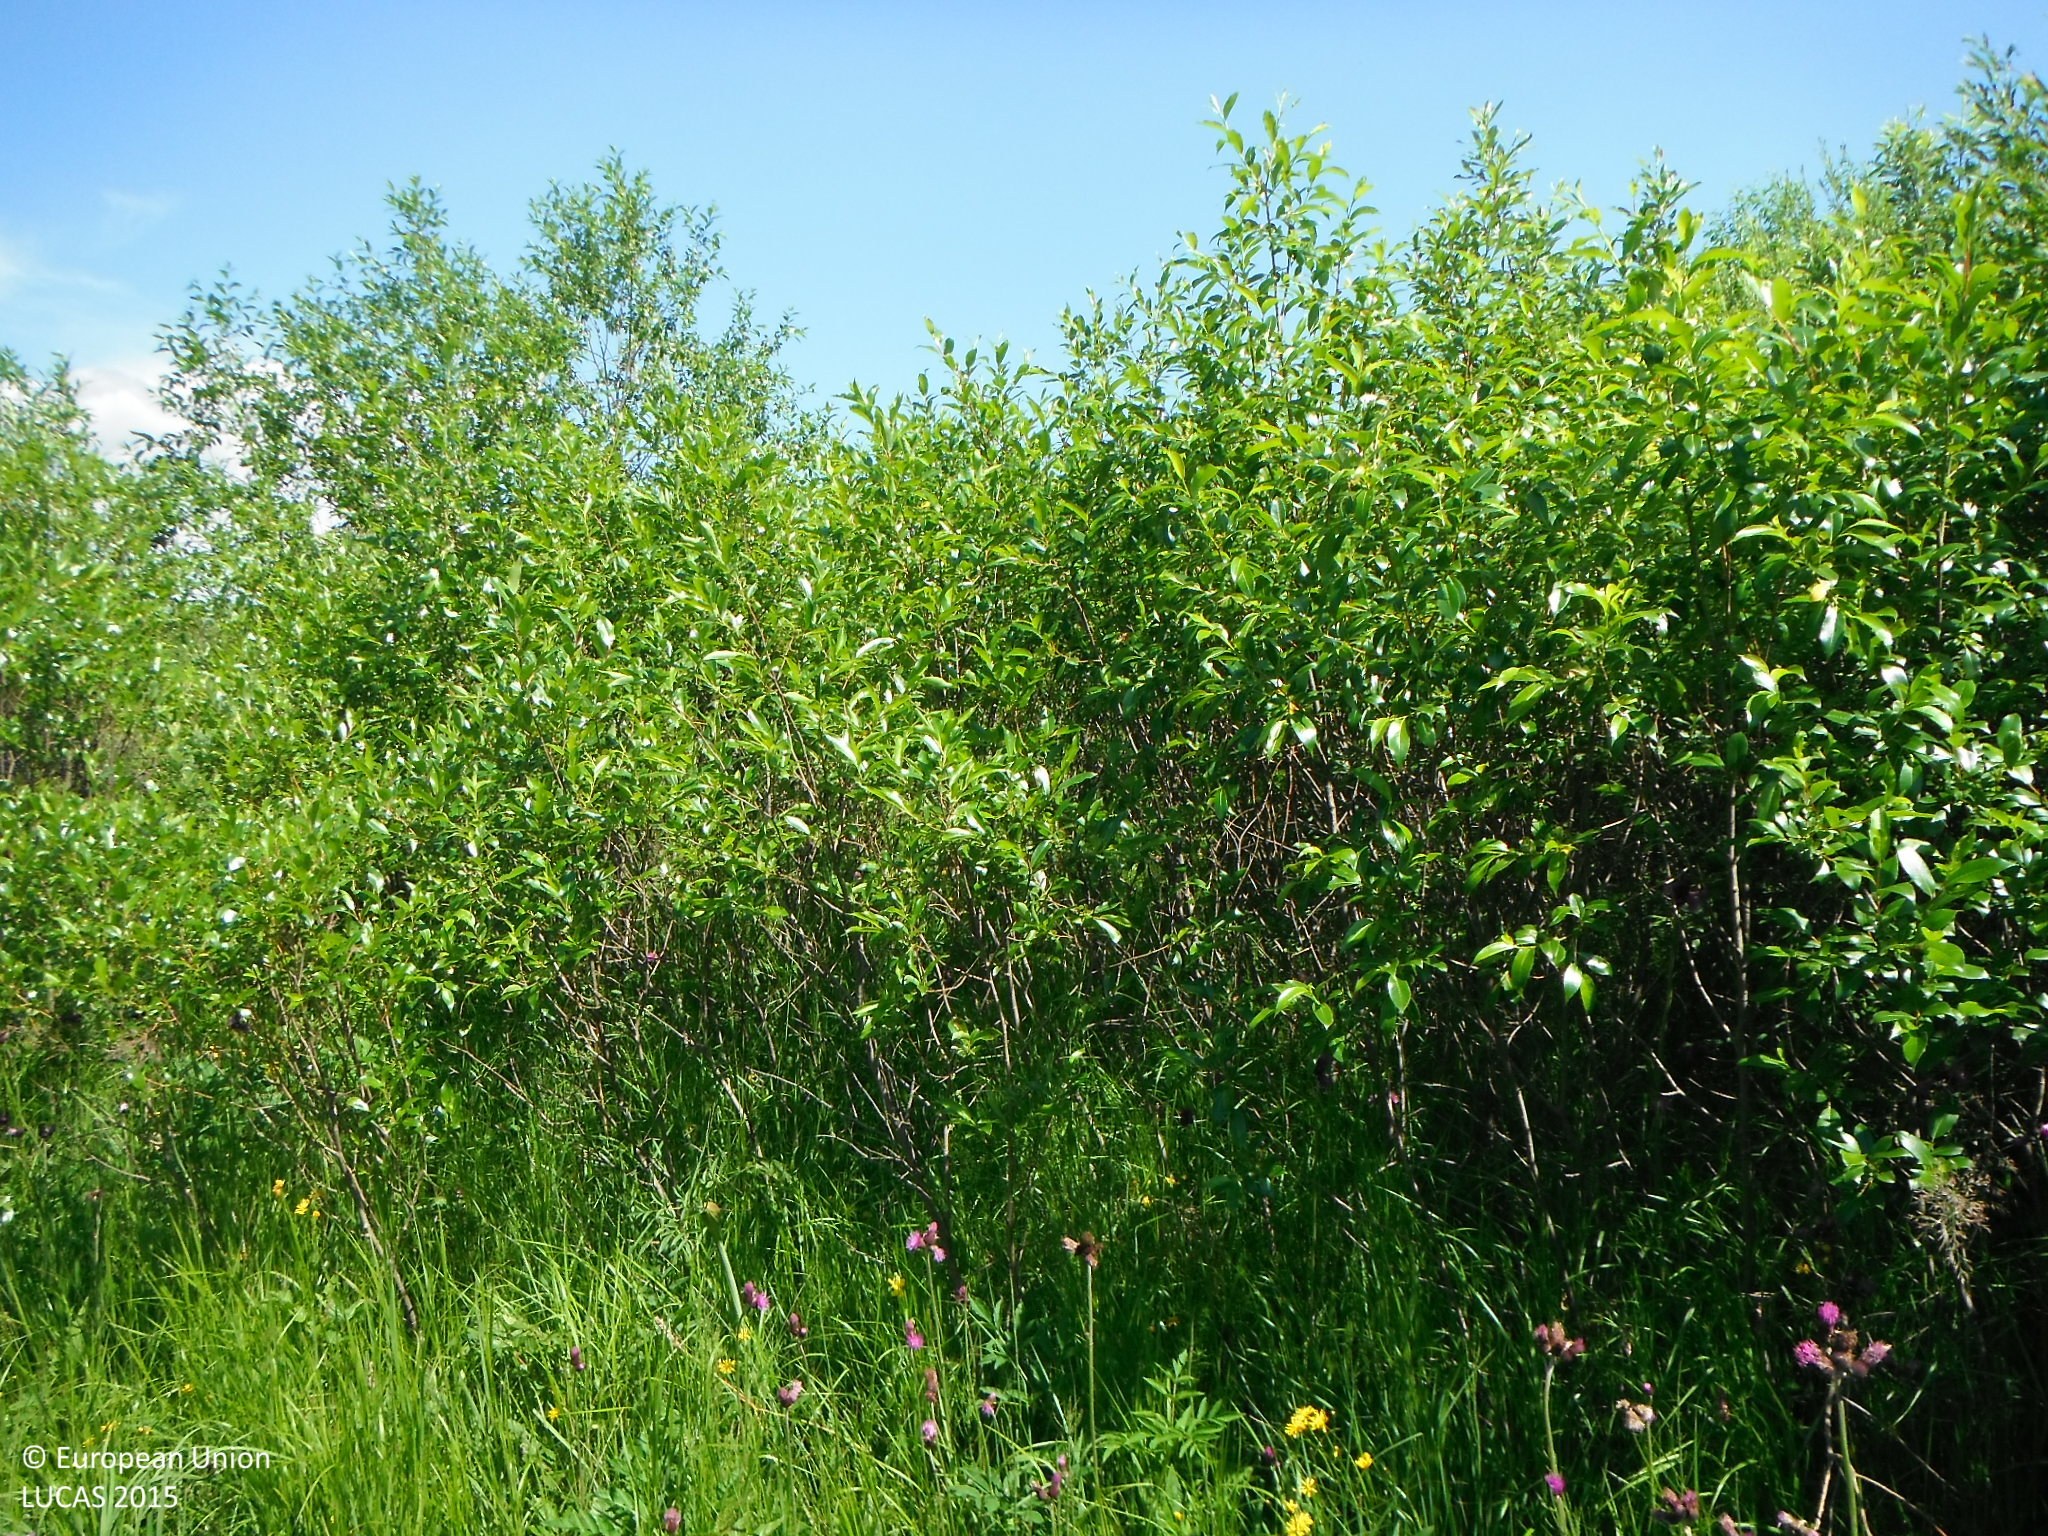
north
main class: Shrubland
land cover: Shrubland without tree cover
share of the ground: > 75 %
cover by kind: shrubs 80 %, herbaceous plants 20 %
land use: Semi-natural and natural areas not in use
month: July
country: SK
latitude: 49.4207
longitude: 19.3303
